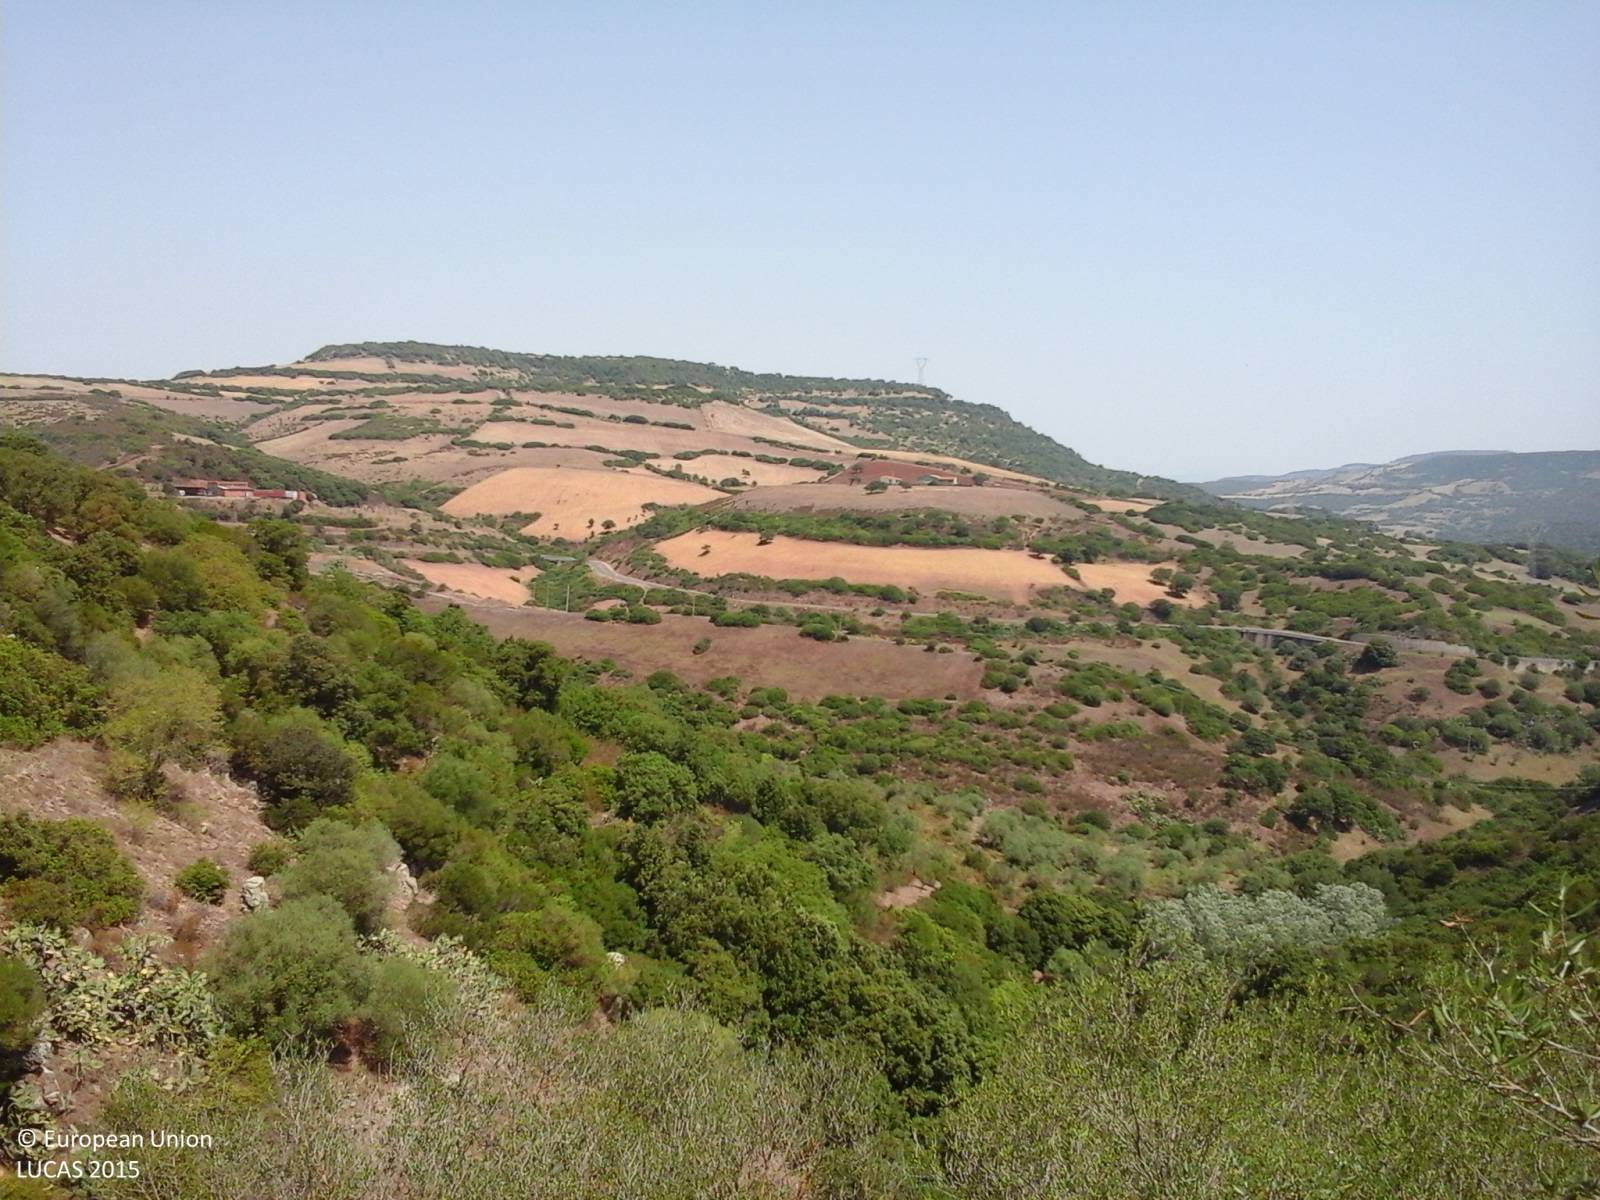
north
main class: Woodland
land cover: Broadleaved woodland
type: broadleaved evergreen forest
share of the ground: 50 - 75 %
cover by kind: broadleaved forest trees 100 %
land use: Forestry
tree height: < 5 m
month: July
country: IT
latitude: 39.9528
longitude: 8.8475
